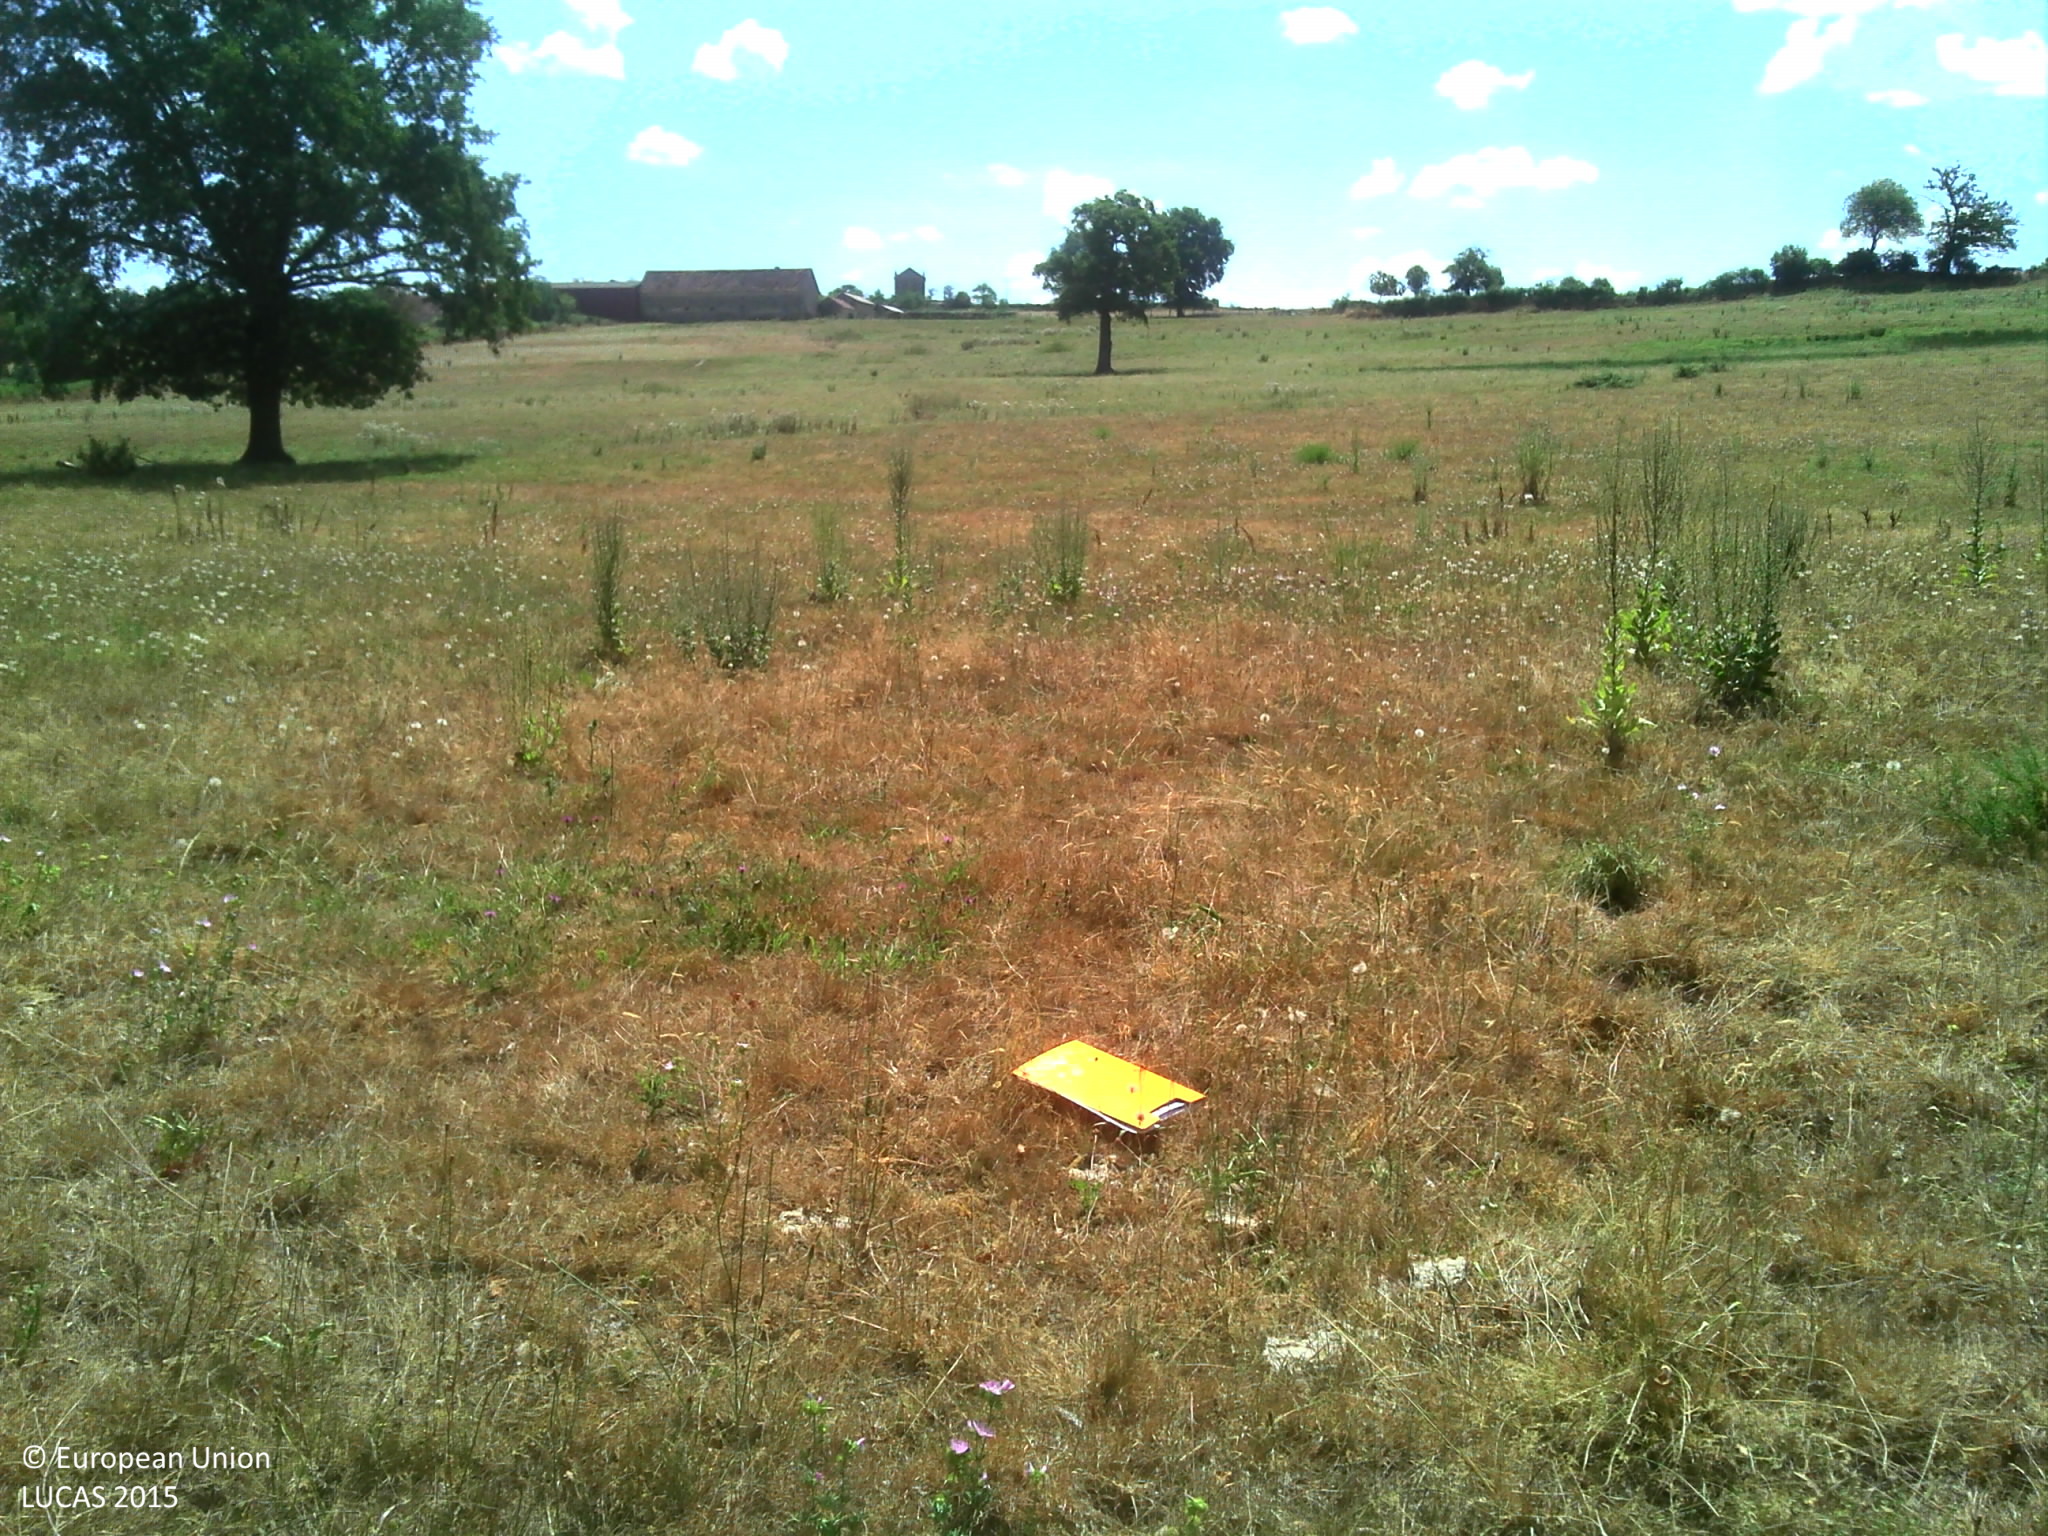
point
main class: Grassland
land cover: Grassland without tree/shrub cover
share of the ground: > 75 %
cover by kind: herbaceous plants 100 %
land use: Agriculture (excluding fallow land and kitchen gardens)
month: July
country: FR
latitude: 46.4661
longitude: 2.7429
